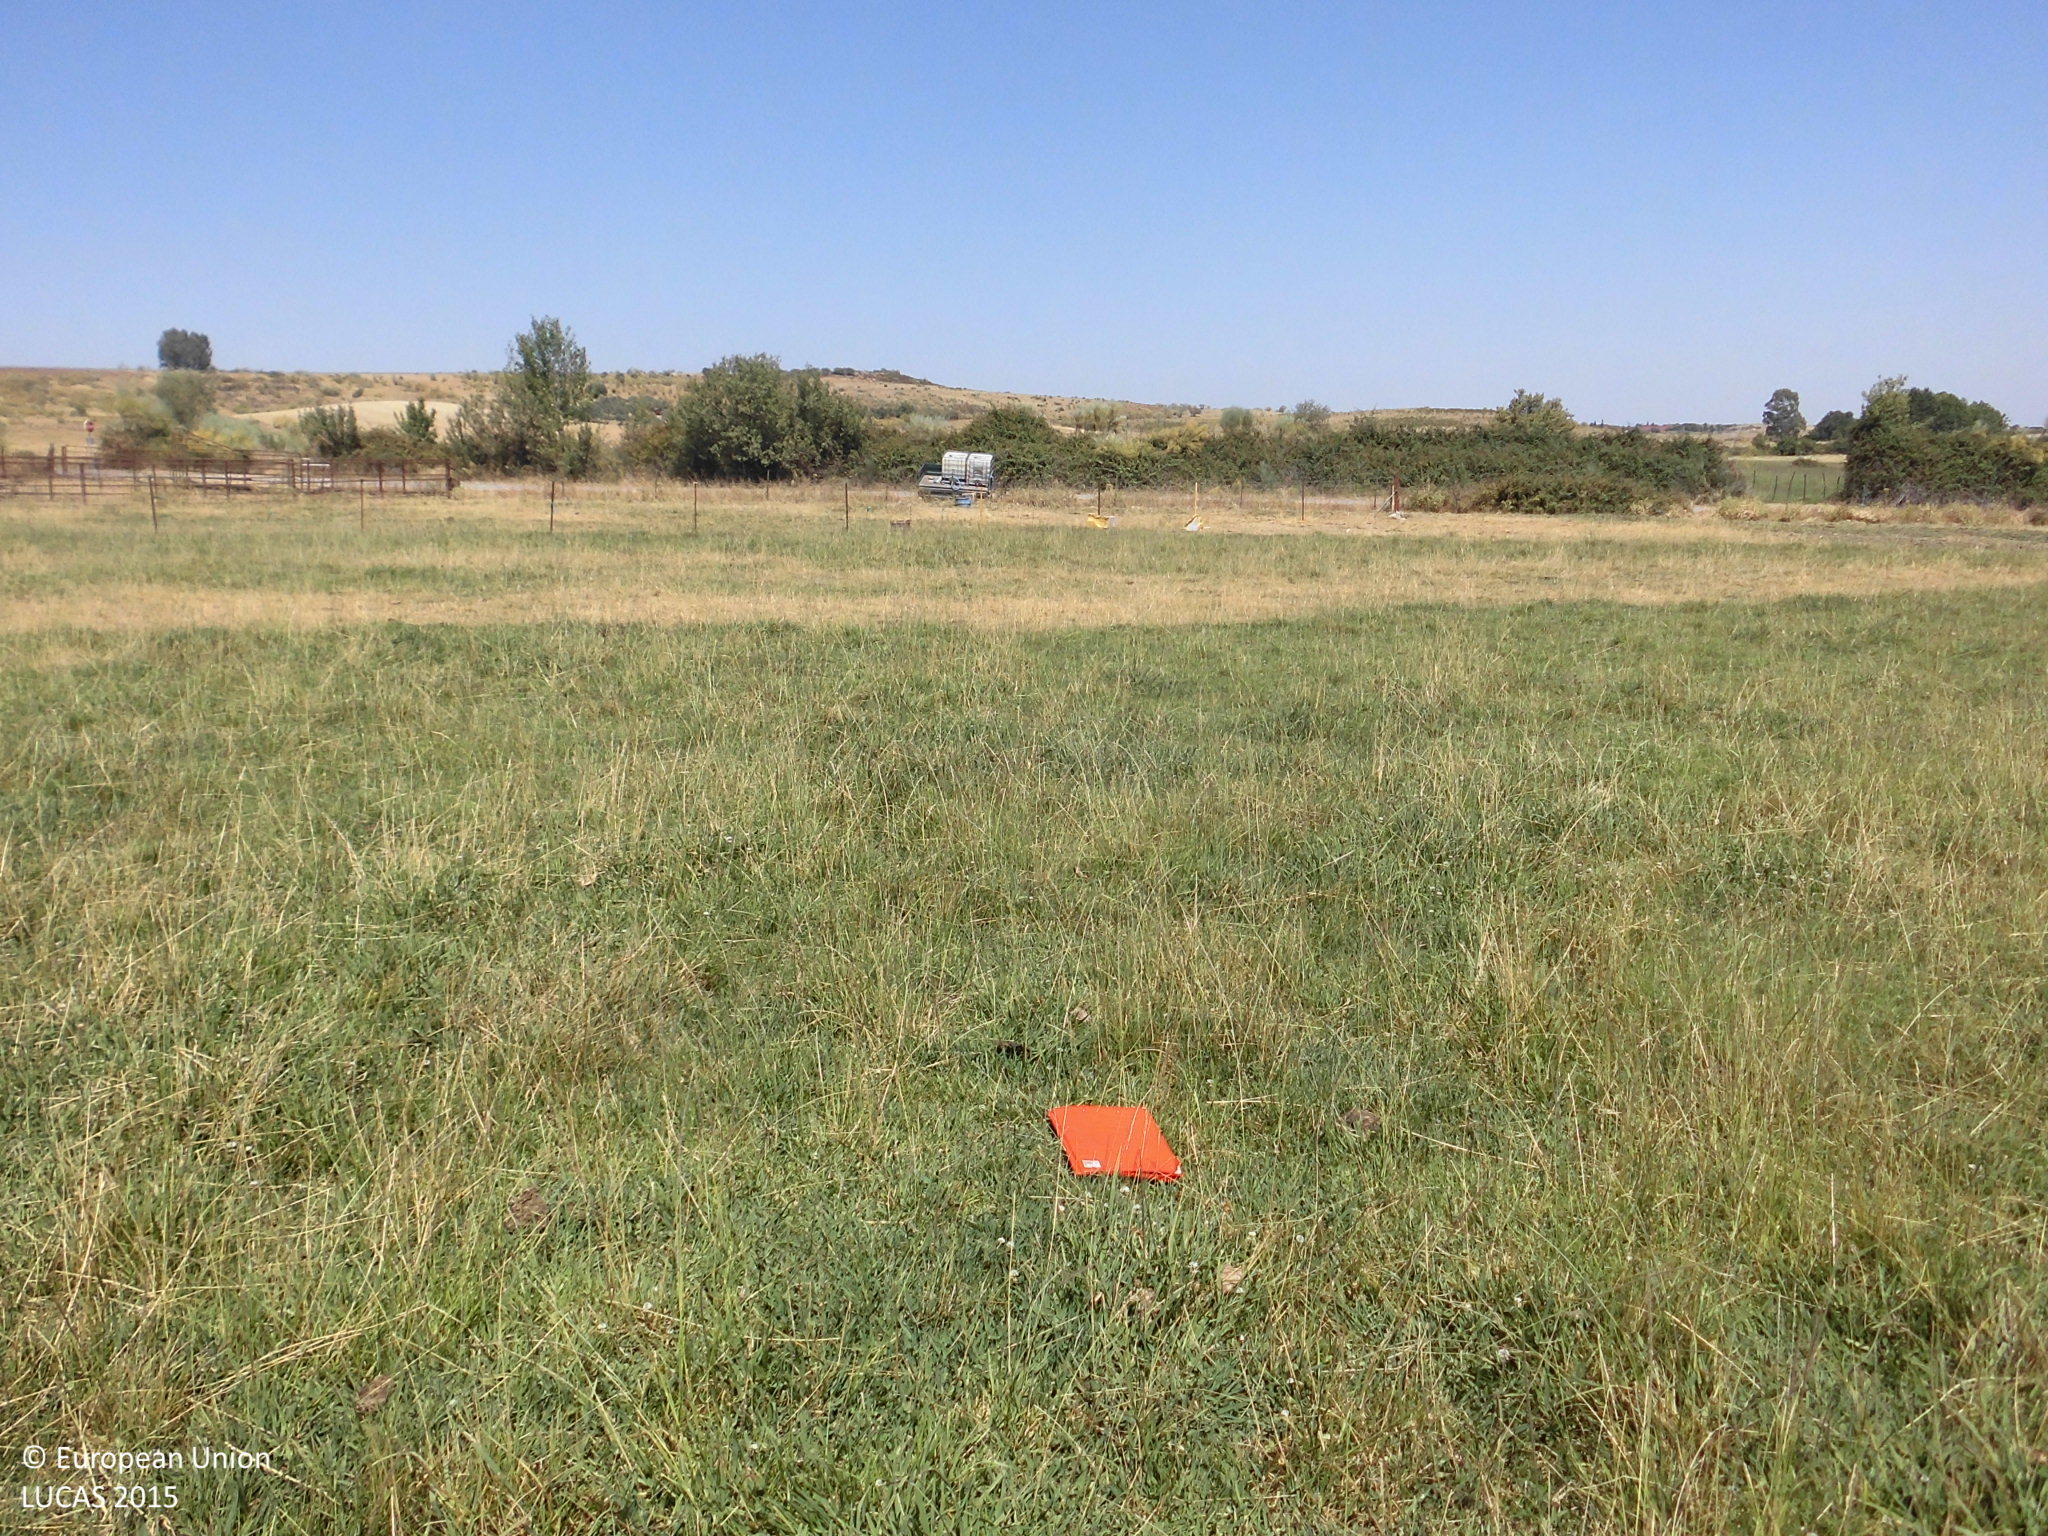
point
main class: Cropland
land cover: Temporary grasslands
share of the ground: > 75 %
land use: Agriculture (excluding fallow land and kitchen gardens)
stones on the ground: 10 - 25 %
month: July
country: ES
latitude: 40.0050
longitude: -6.5866
